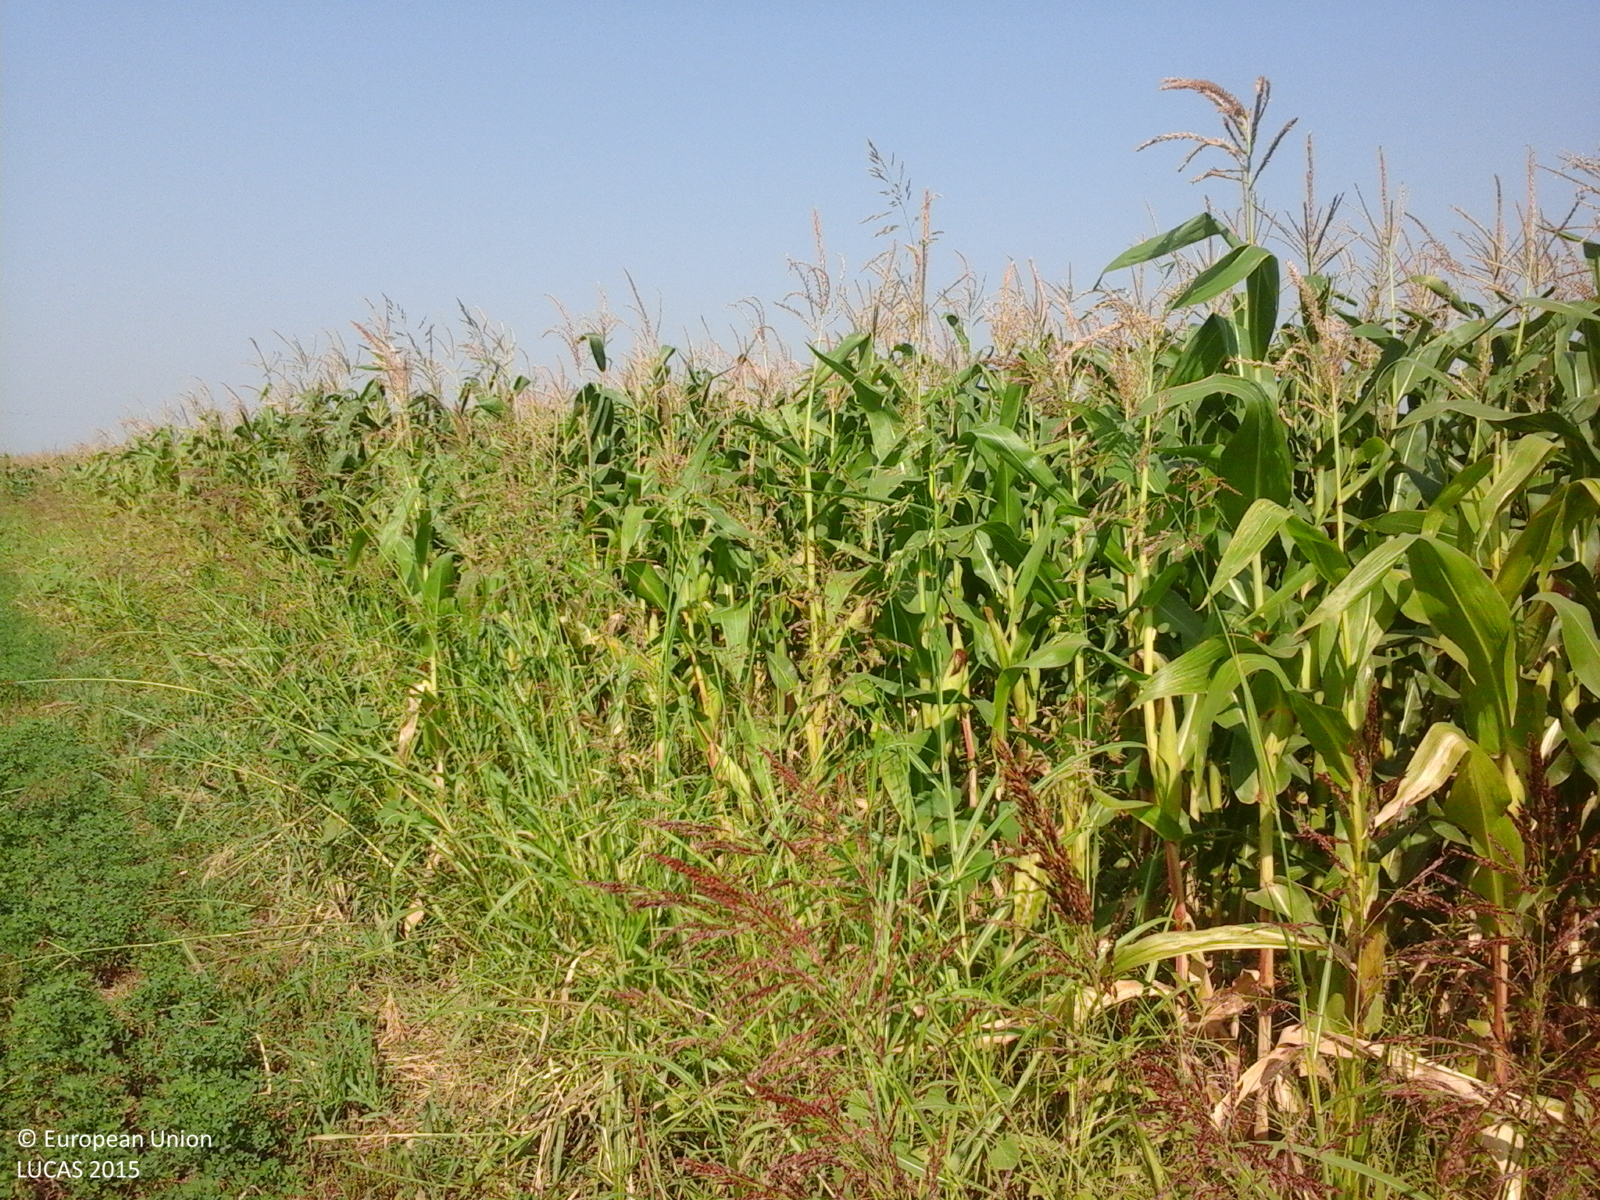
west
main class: Cropland
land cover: Maize
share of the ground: > 75 %
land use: Agriculture (excluding fallow land and kitchen gardens)
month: August
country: RO
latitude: 45.1274
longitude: 27.4260
